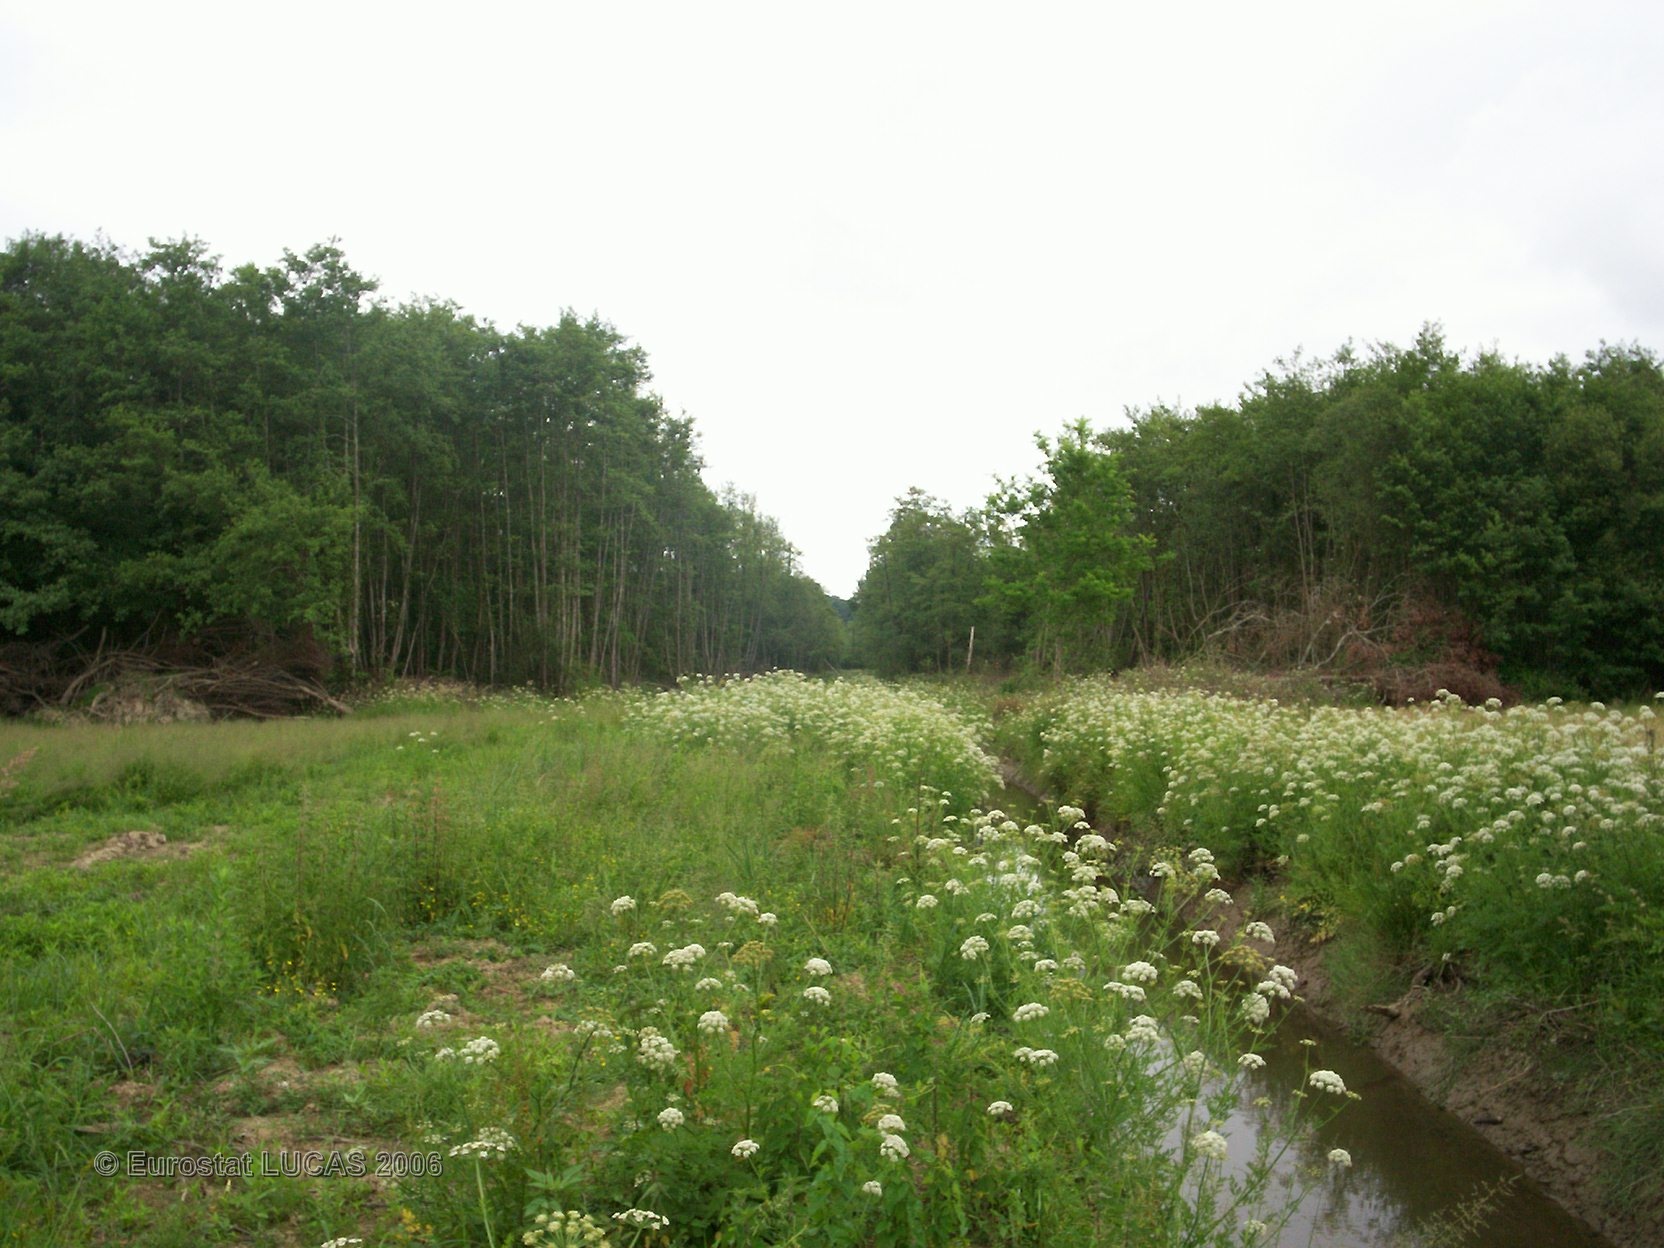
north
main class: Grassland
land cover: Grassland without tree/shrub cover
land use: Agriculture (excluding fallow land and kitchen gardens)
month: May
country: FR
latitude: 43.5035
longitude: -1.3838
